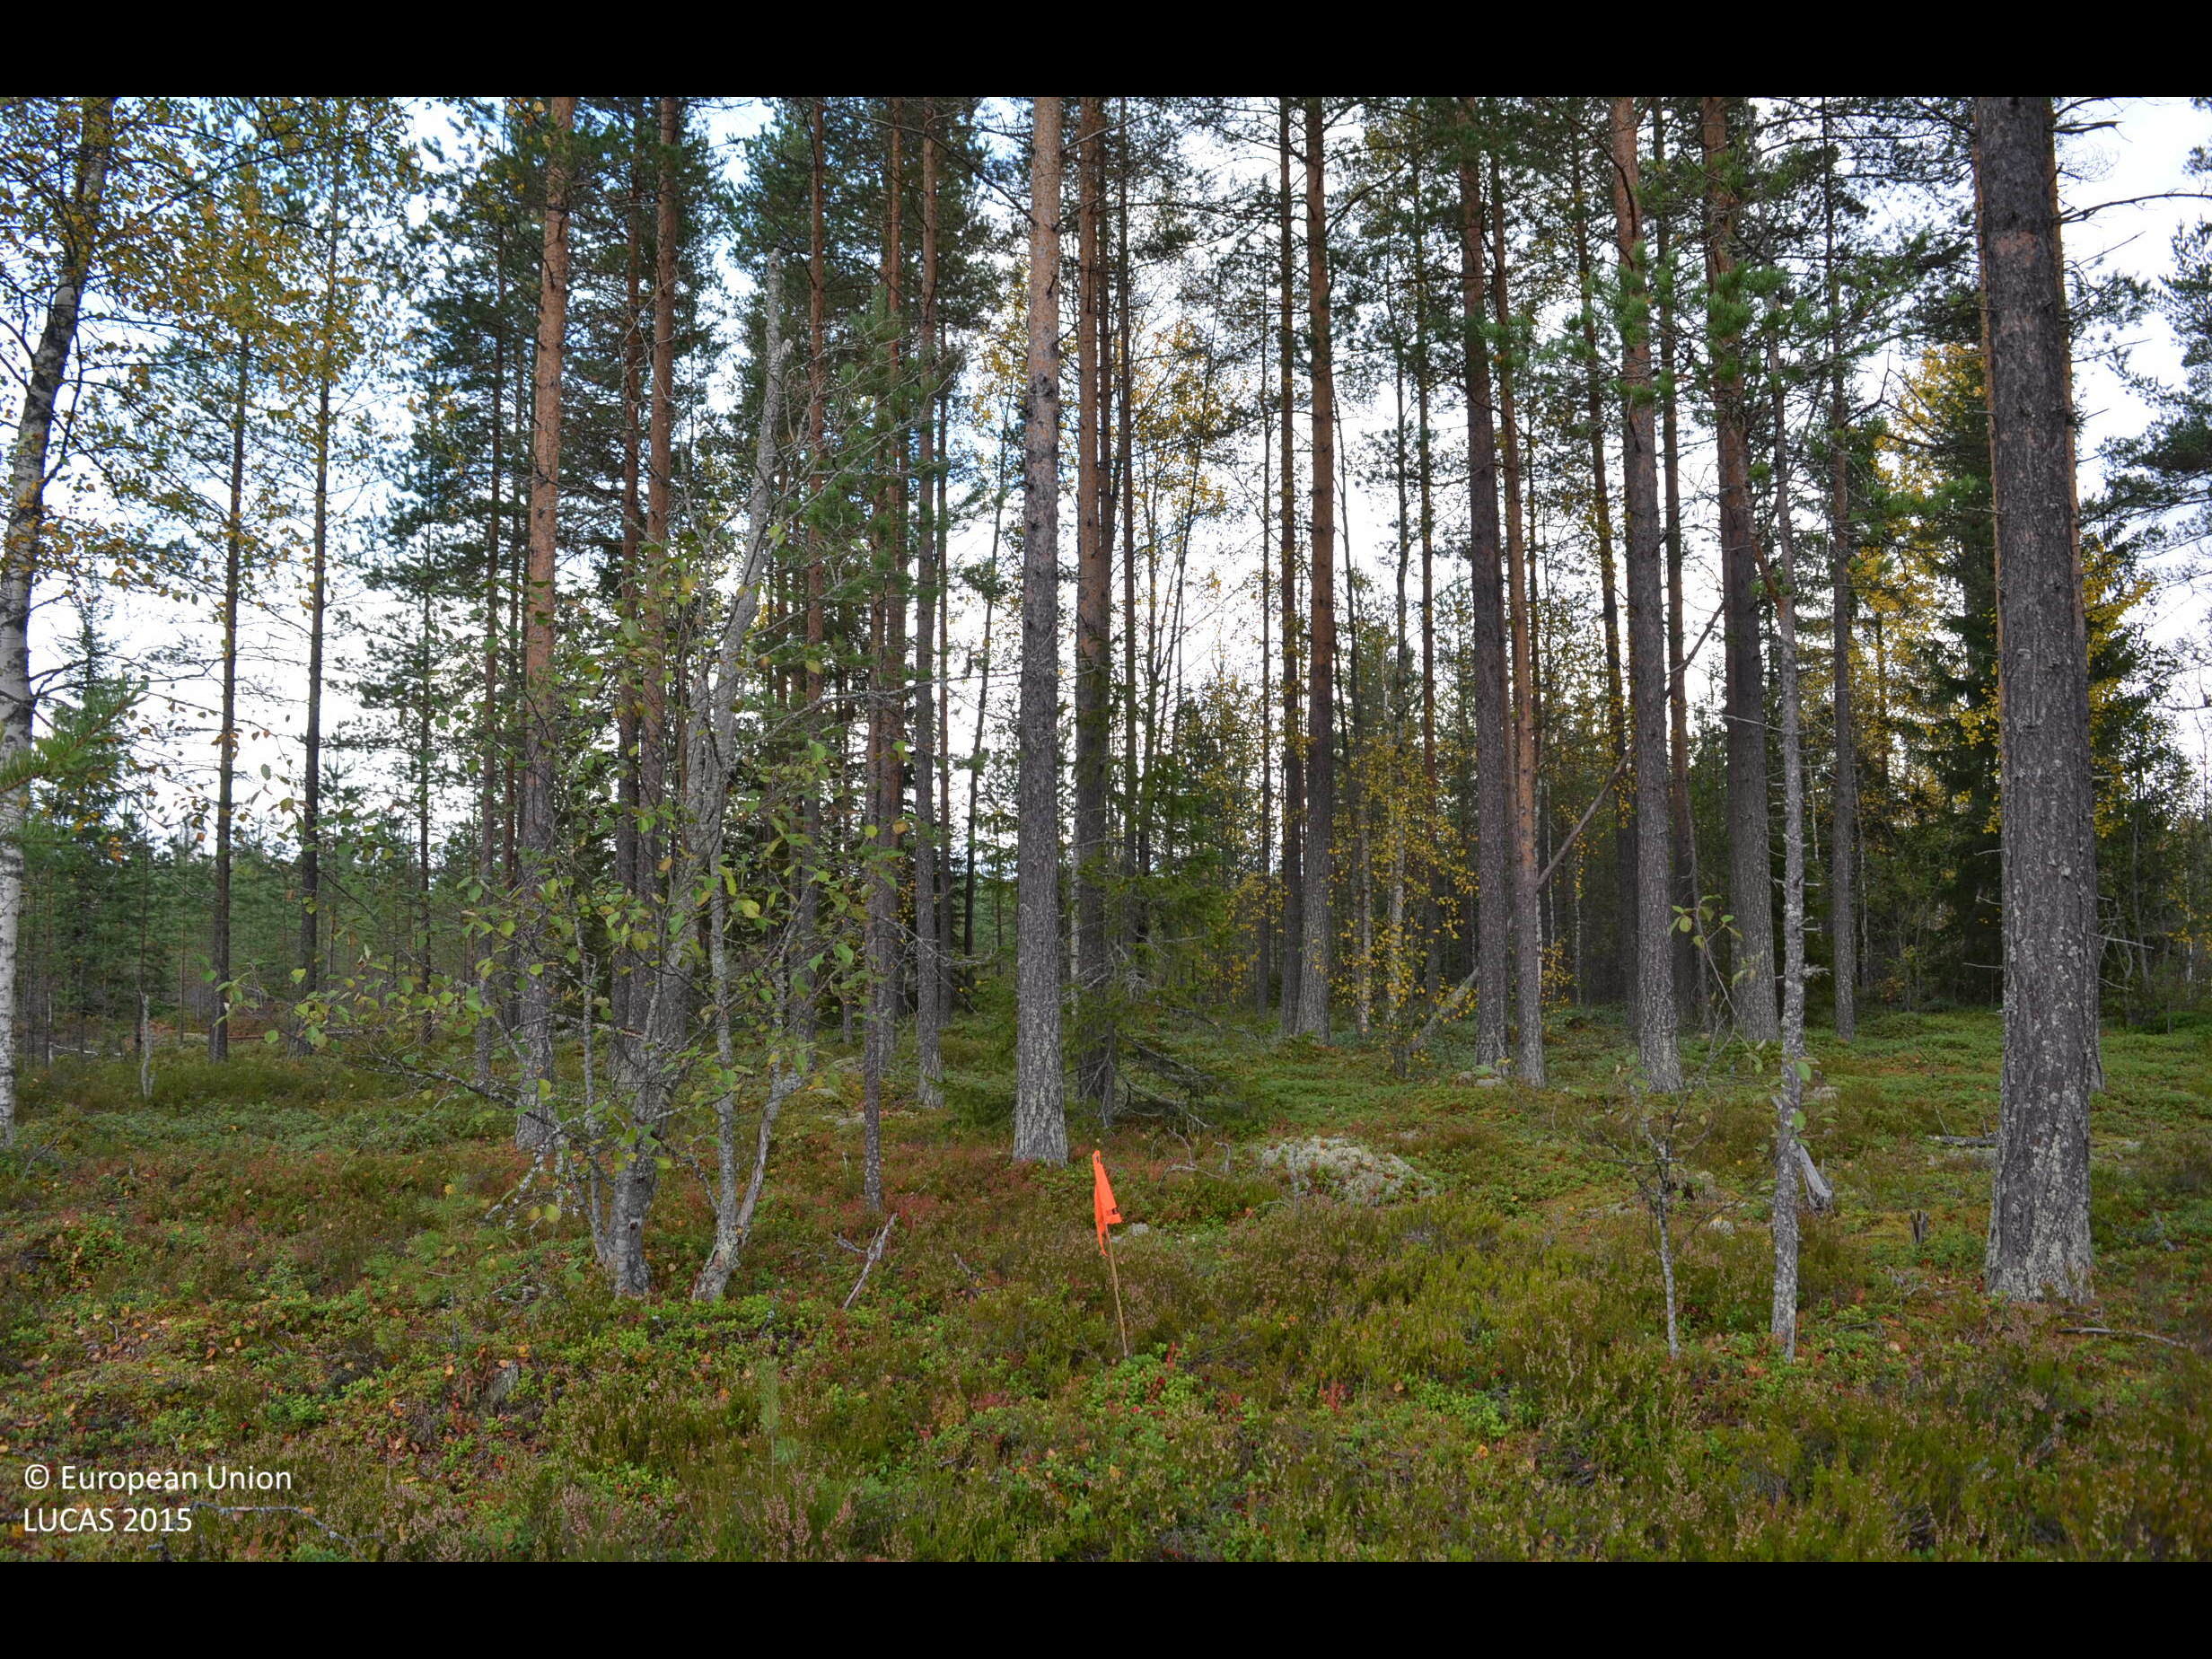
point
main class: Woodland
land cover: Other mixed woodland
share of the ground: 50 - 75 %
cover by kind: coniferous forest trees 45 %, broadleaved forest trees 25 %, shrubs 15 %, lichens and mosses 15 %
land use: Forestry
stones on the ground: < 10 %
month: September
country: FI
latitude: 62.7691
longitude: 23.7263
